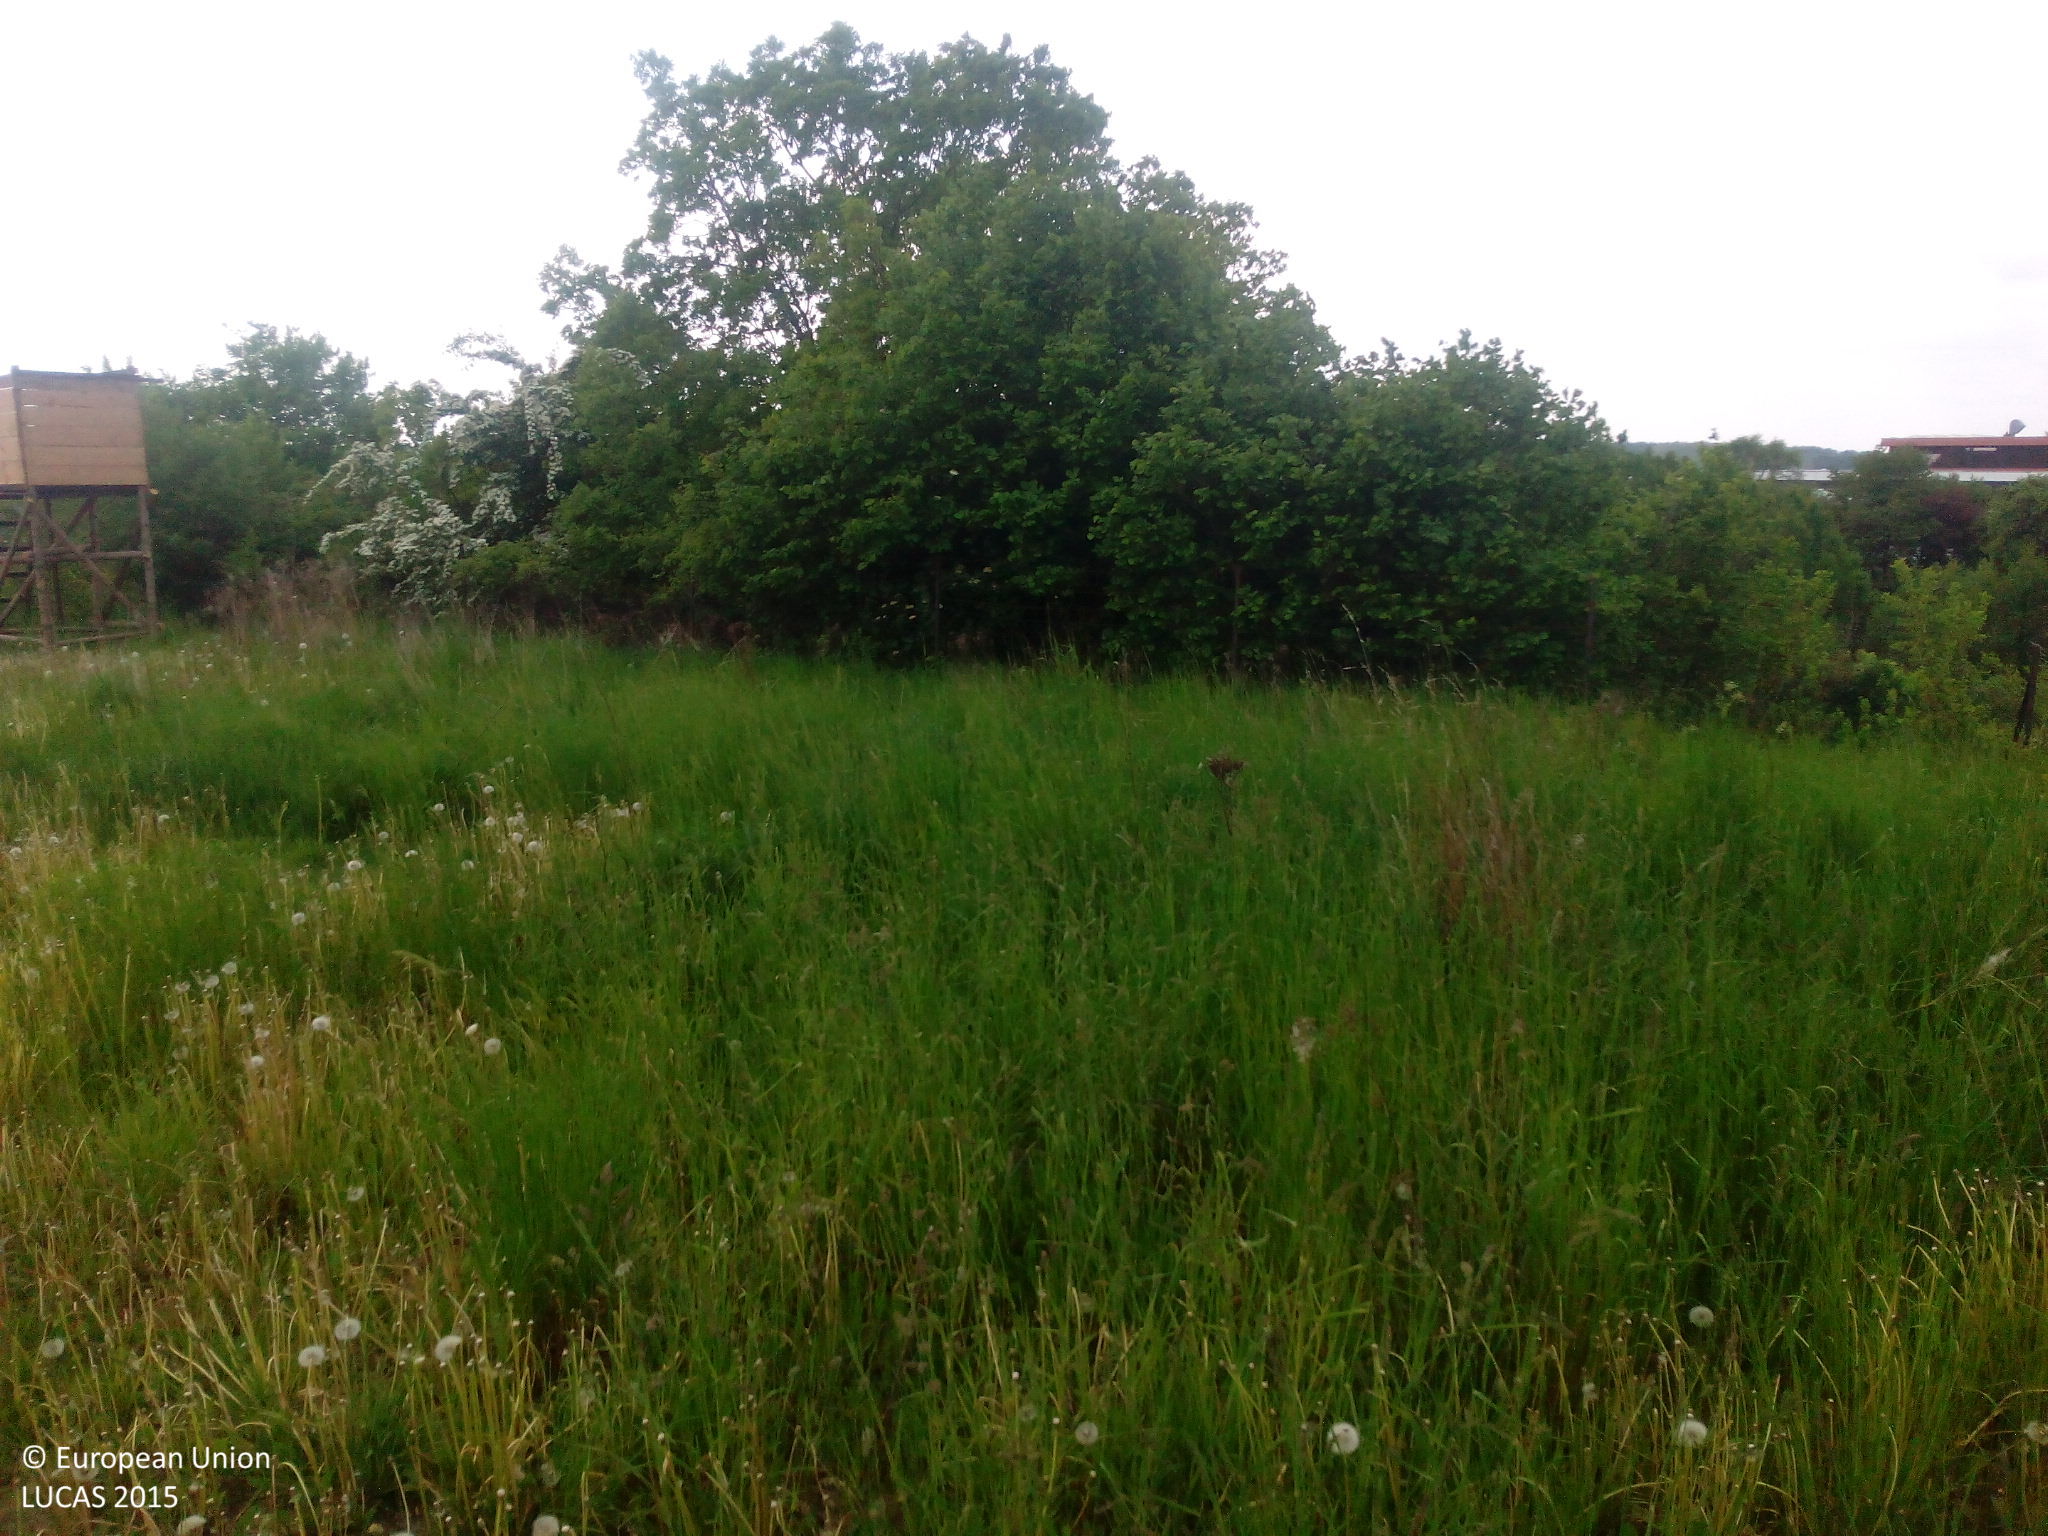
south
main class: Cropland
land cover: Rape and turnip rape
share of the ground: > 75 %
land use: Agriculture (excluding fallow land and kitchen gardens)
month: May
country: DE
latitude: 50.2336
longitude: 11.0231
